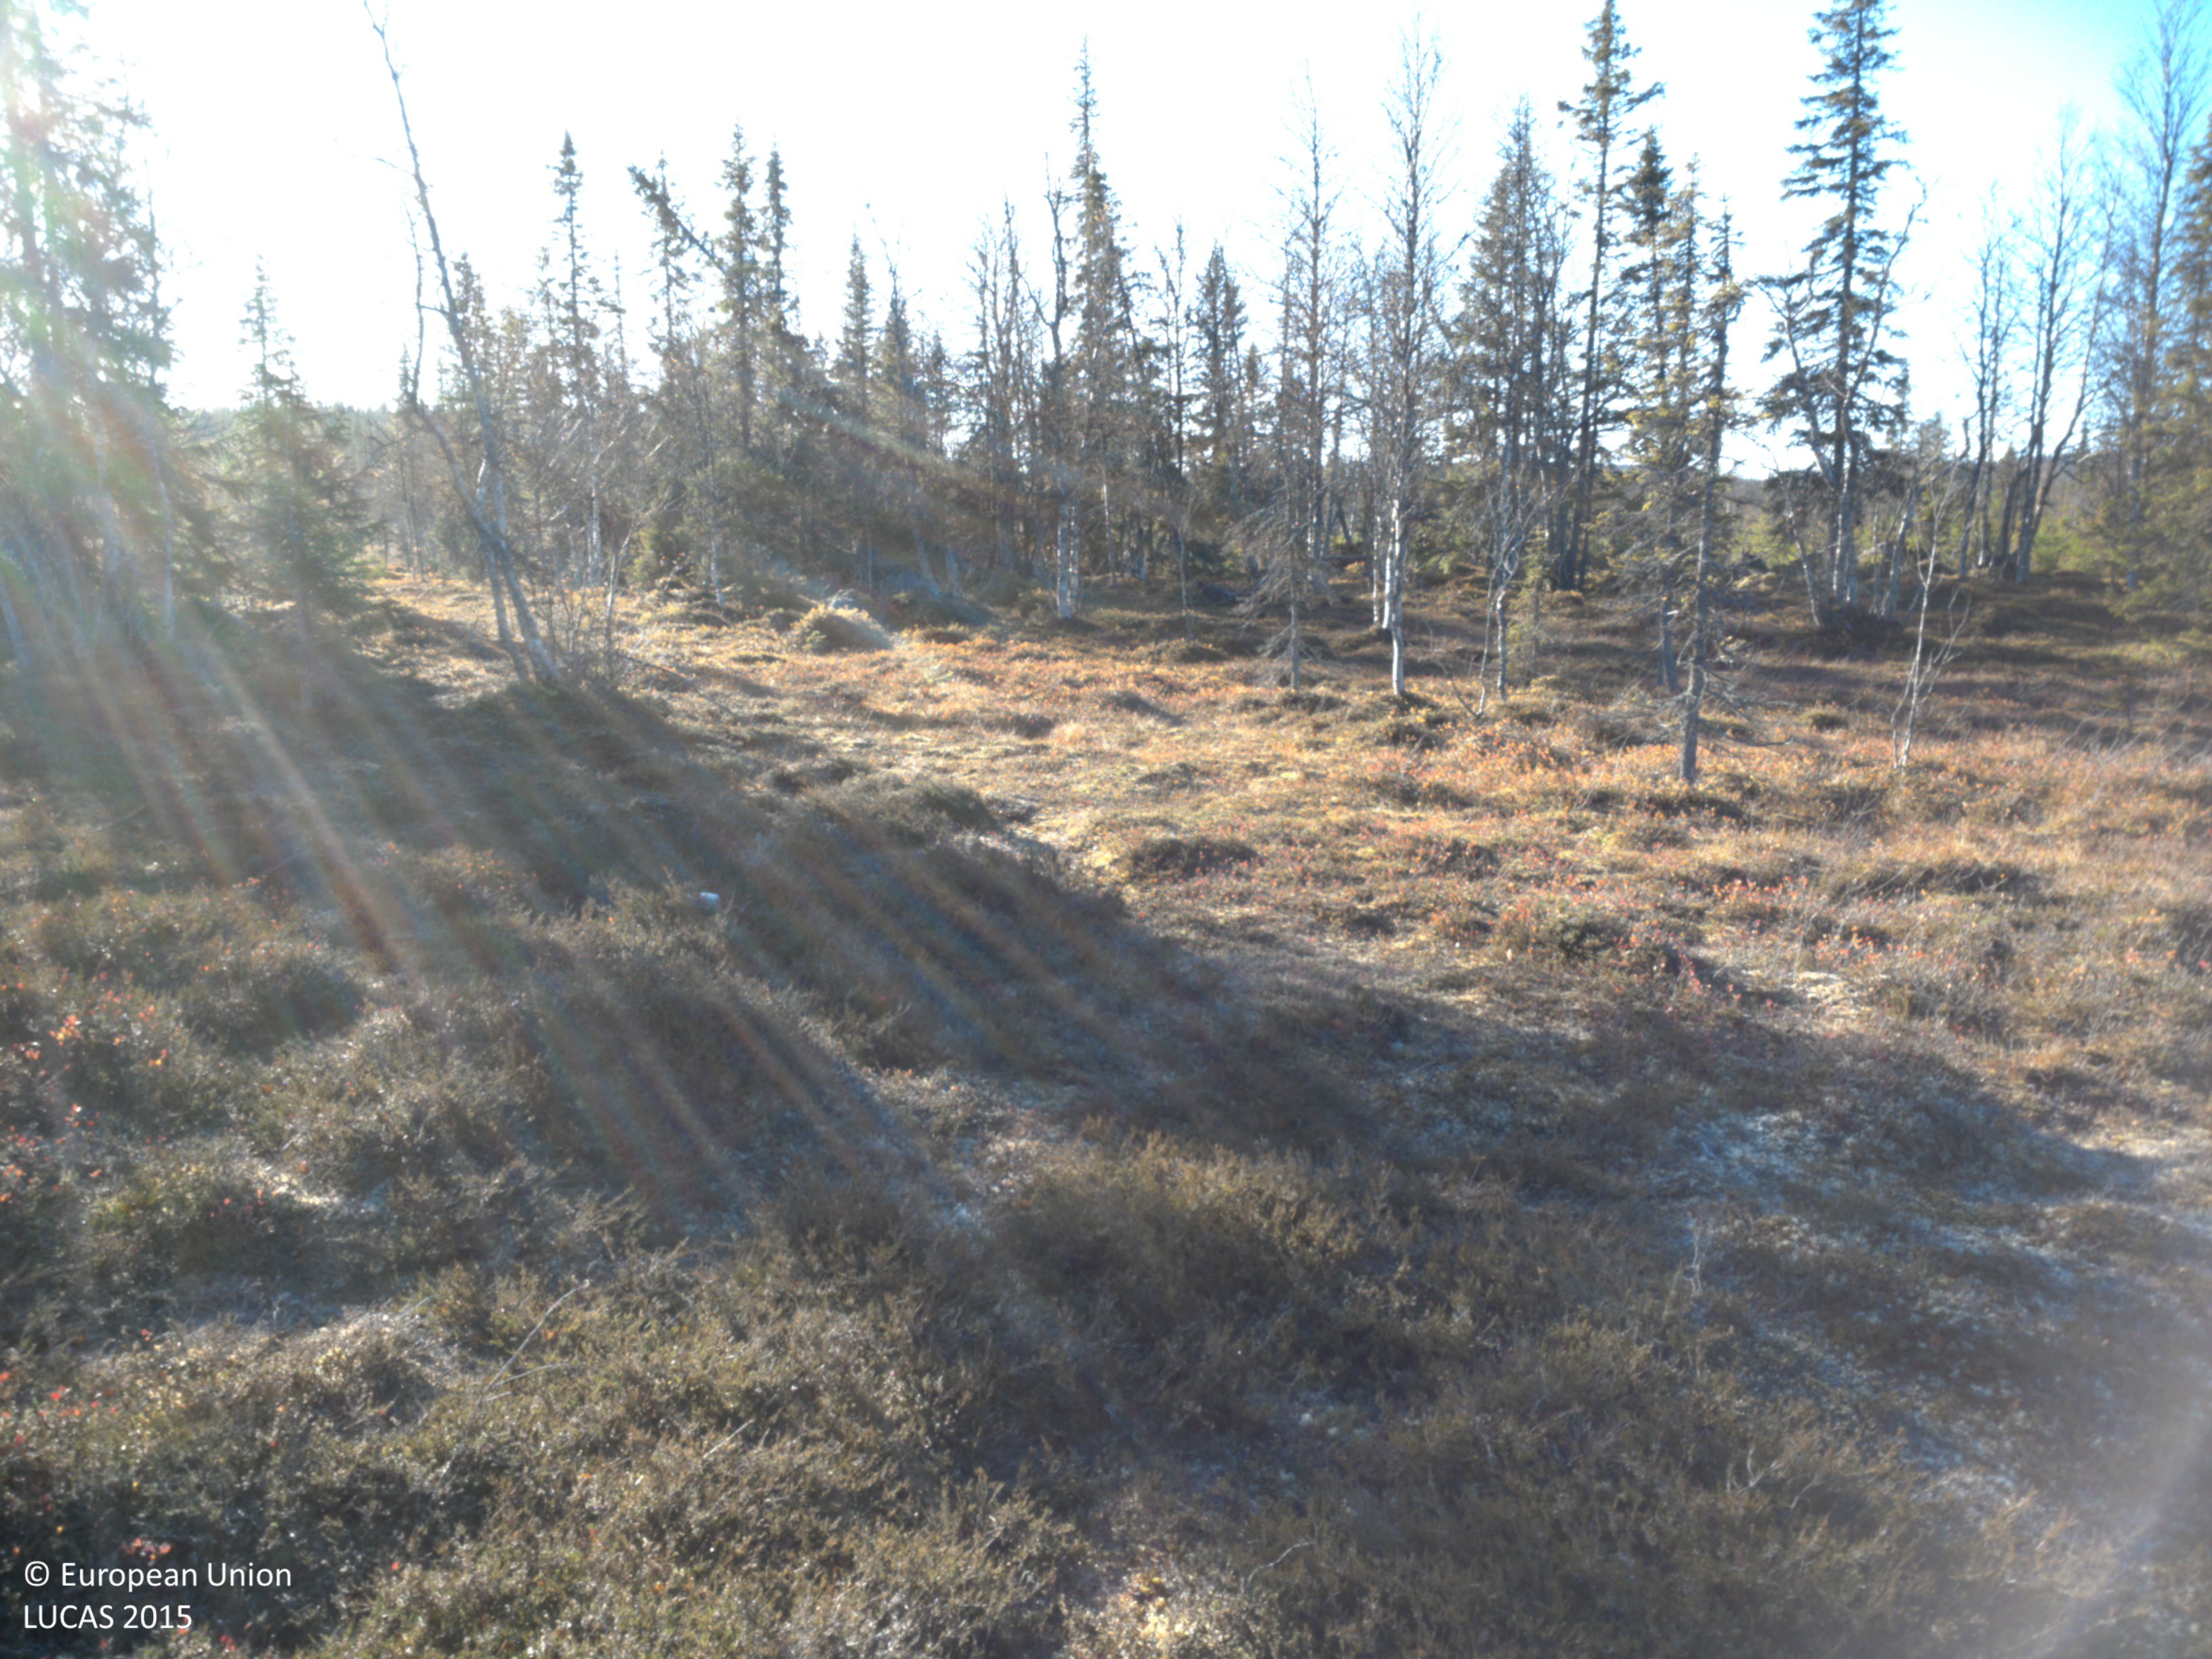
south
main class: Woodland
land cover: Spruce dominated mixed woodland
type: boreal forest
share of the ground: 25 - 50 %
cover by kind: shrubs 35 %, herbaceous plants 30 %, coniferous forest trees 15 %, broadleaved forest trees 15 %, lichens and mosses 5 %
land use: Forestry
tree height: < 5 m
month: October
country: SE
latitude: 64.5917
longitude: 17.7162
